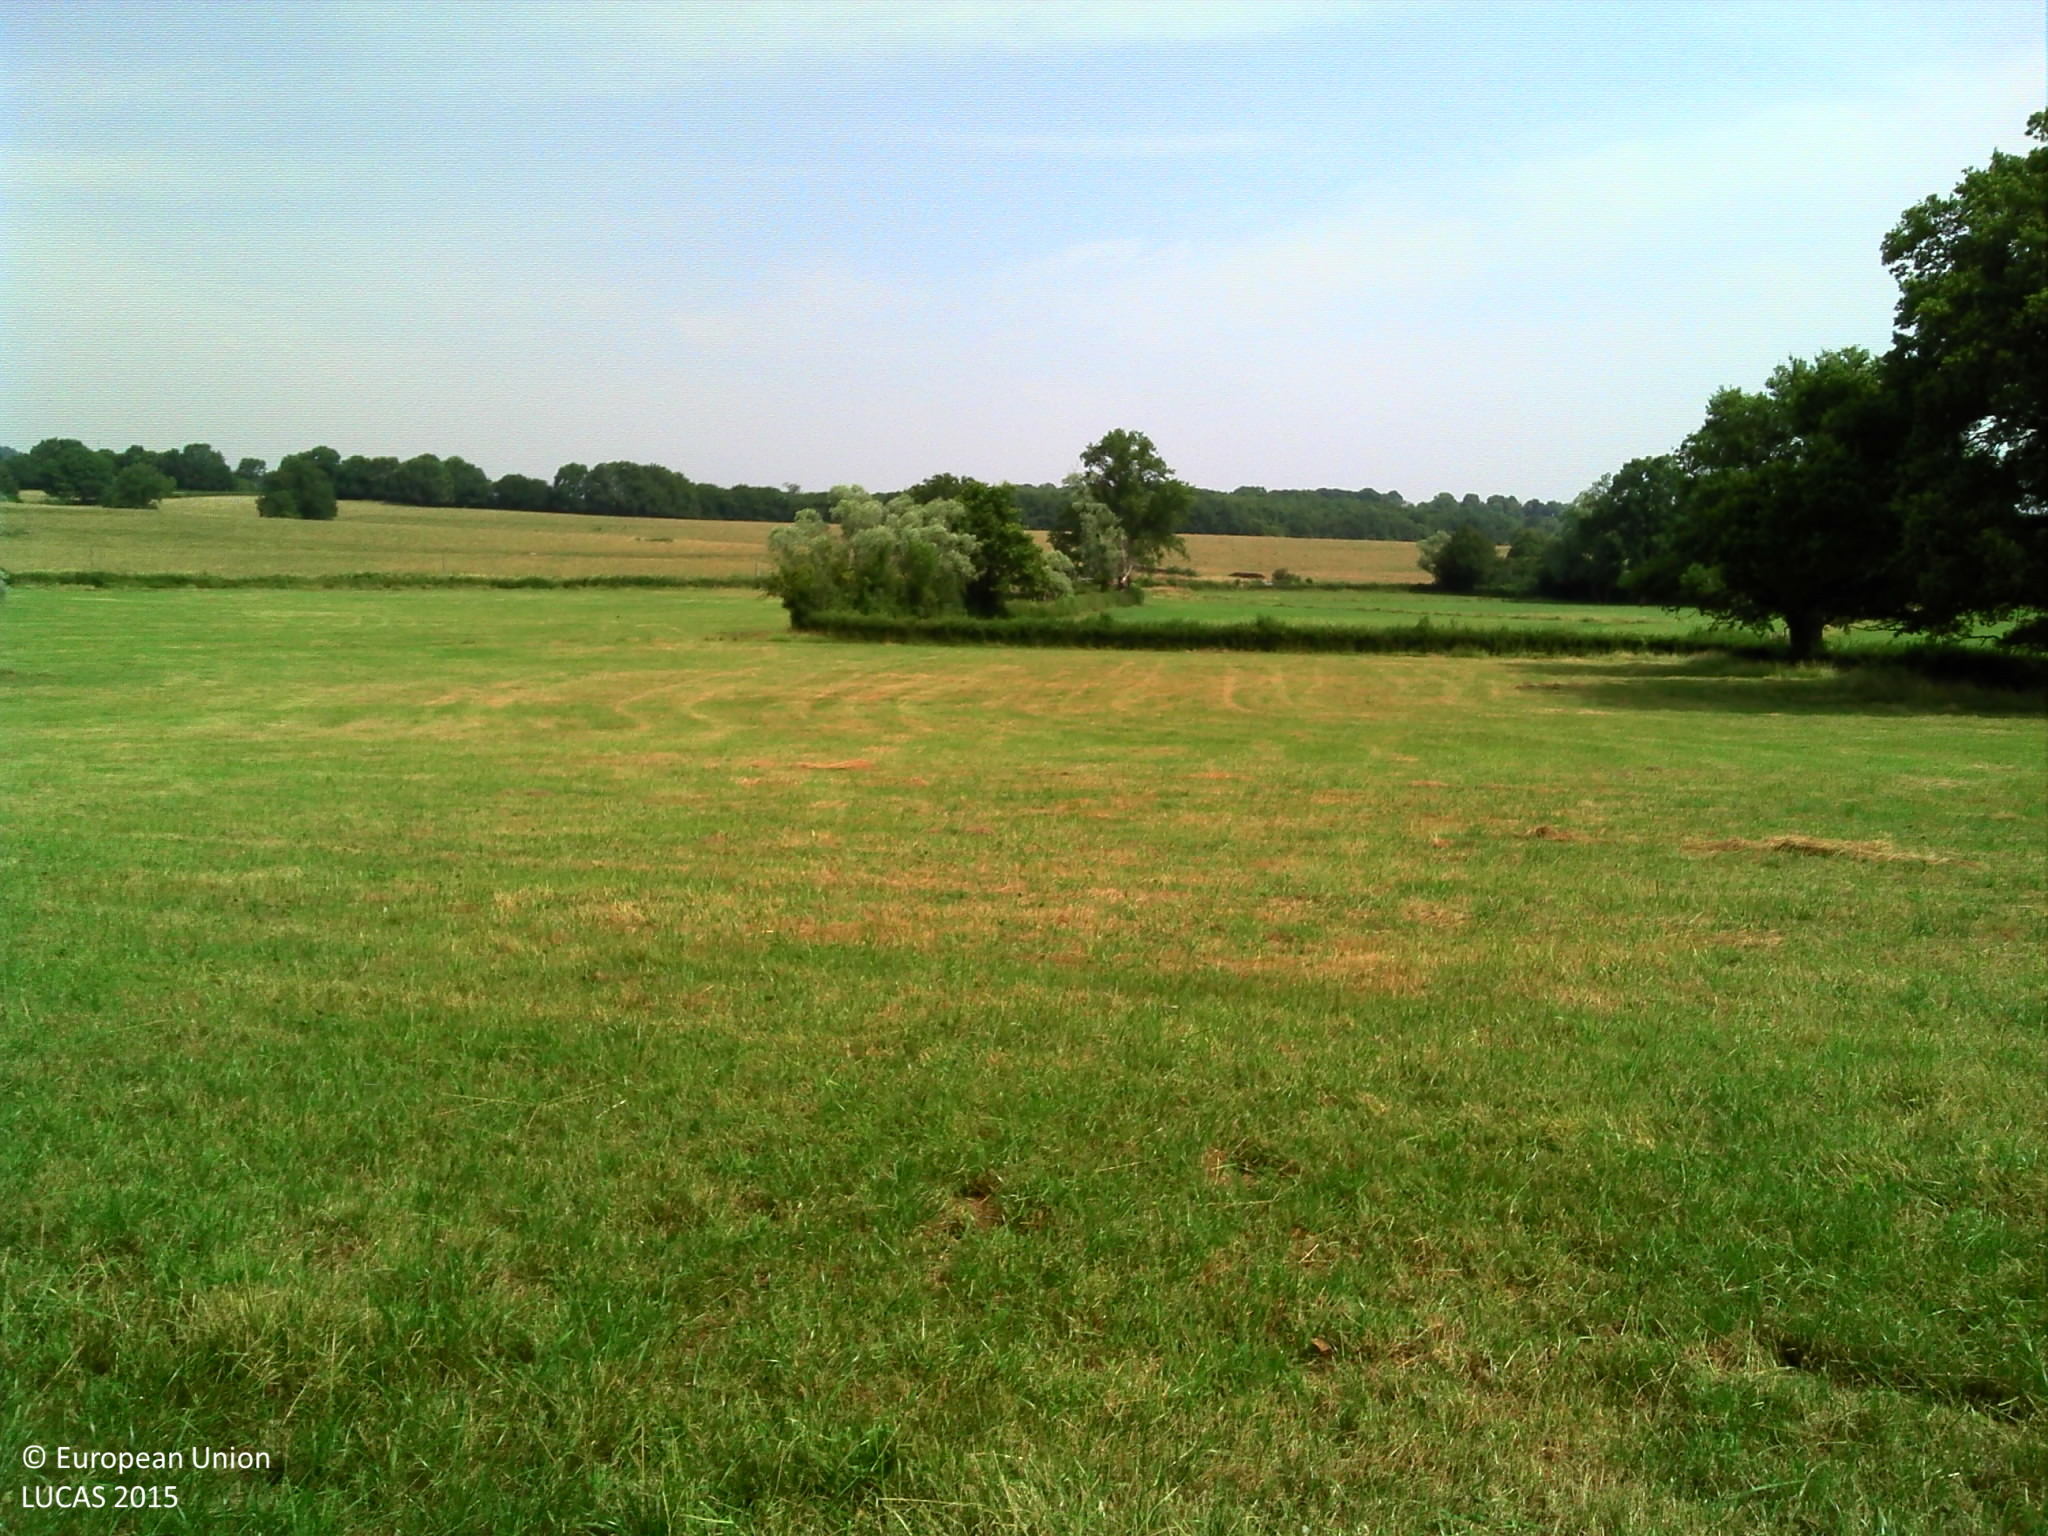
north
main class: Grassland
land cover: Grassland without tree/shrub cover
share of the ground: > 75 %
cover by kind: herbaceous plants 100 %
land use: Agriculture (excluding fallow land and kitchen gardens)
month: July
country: FR
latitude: 47.1124
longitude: 3.5265
